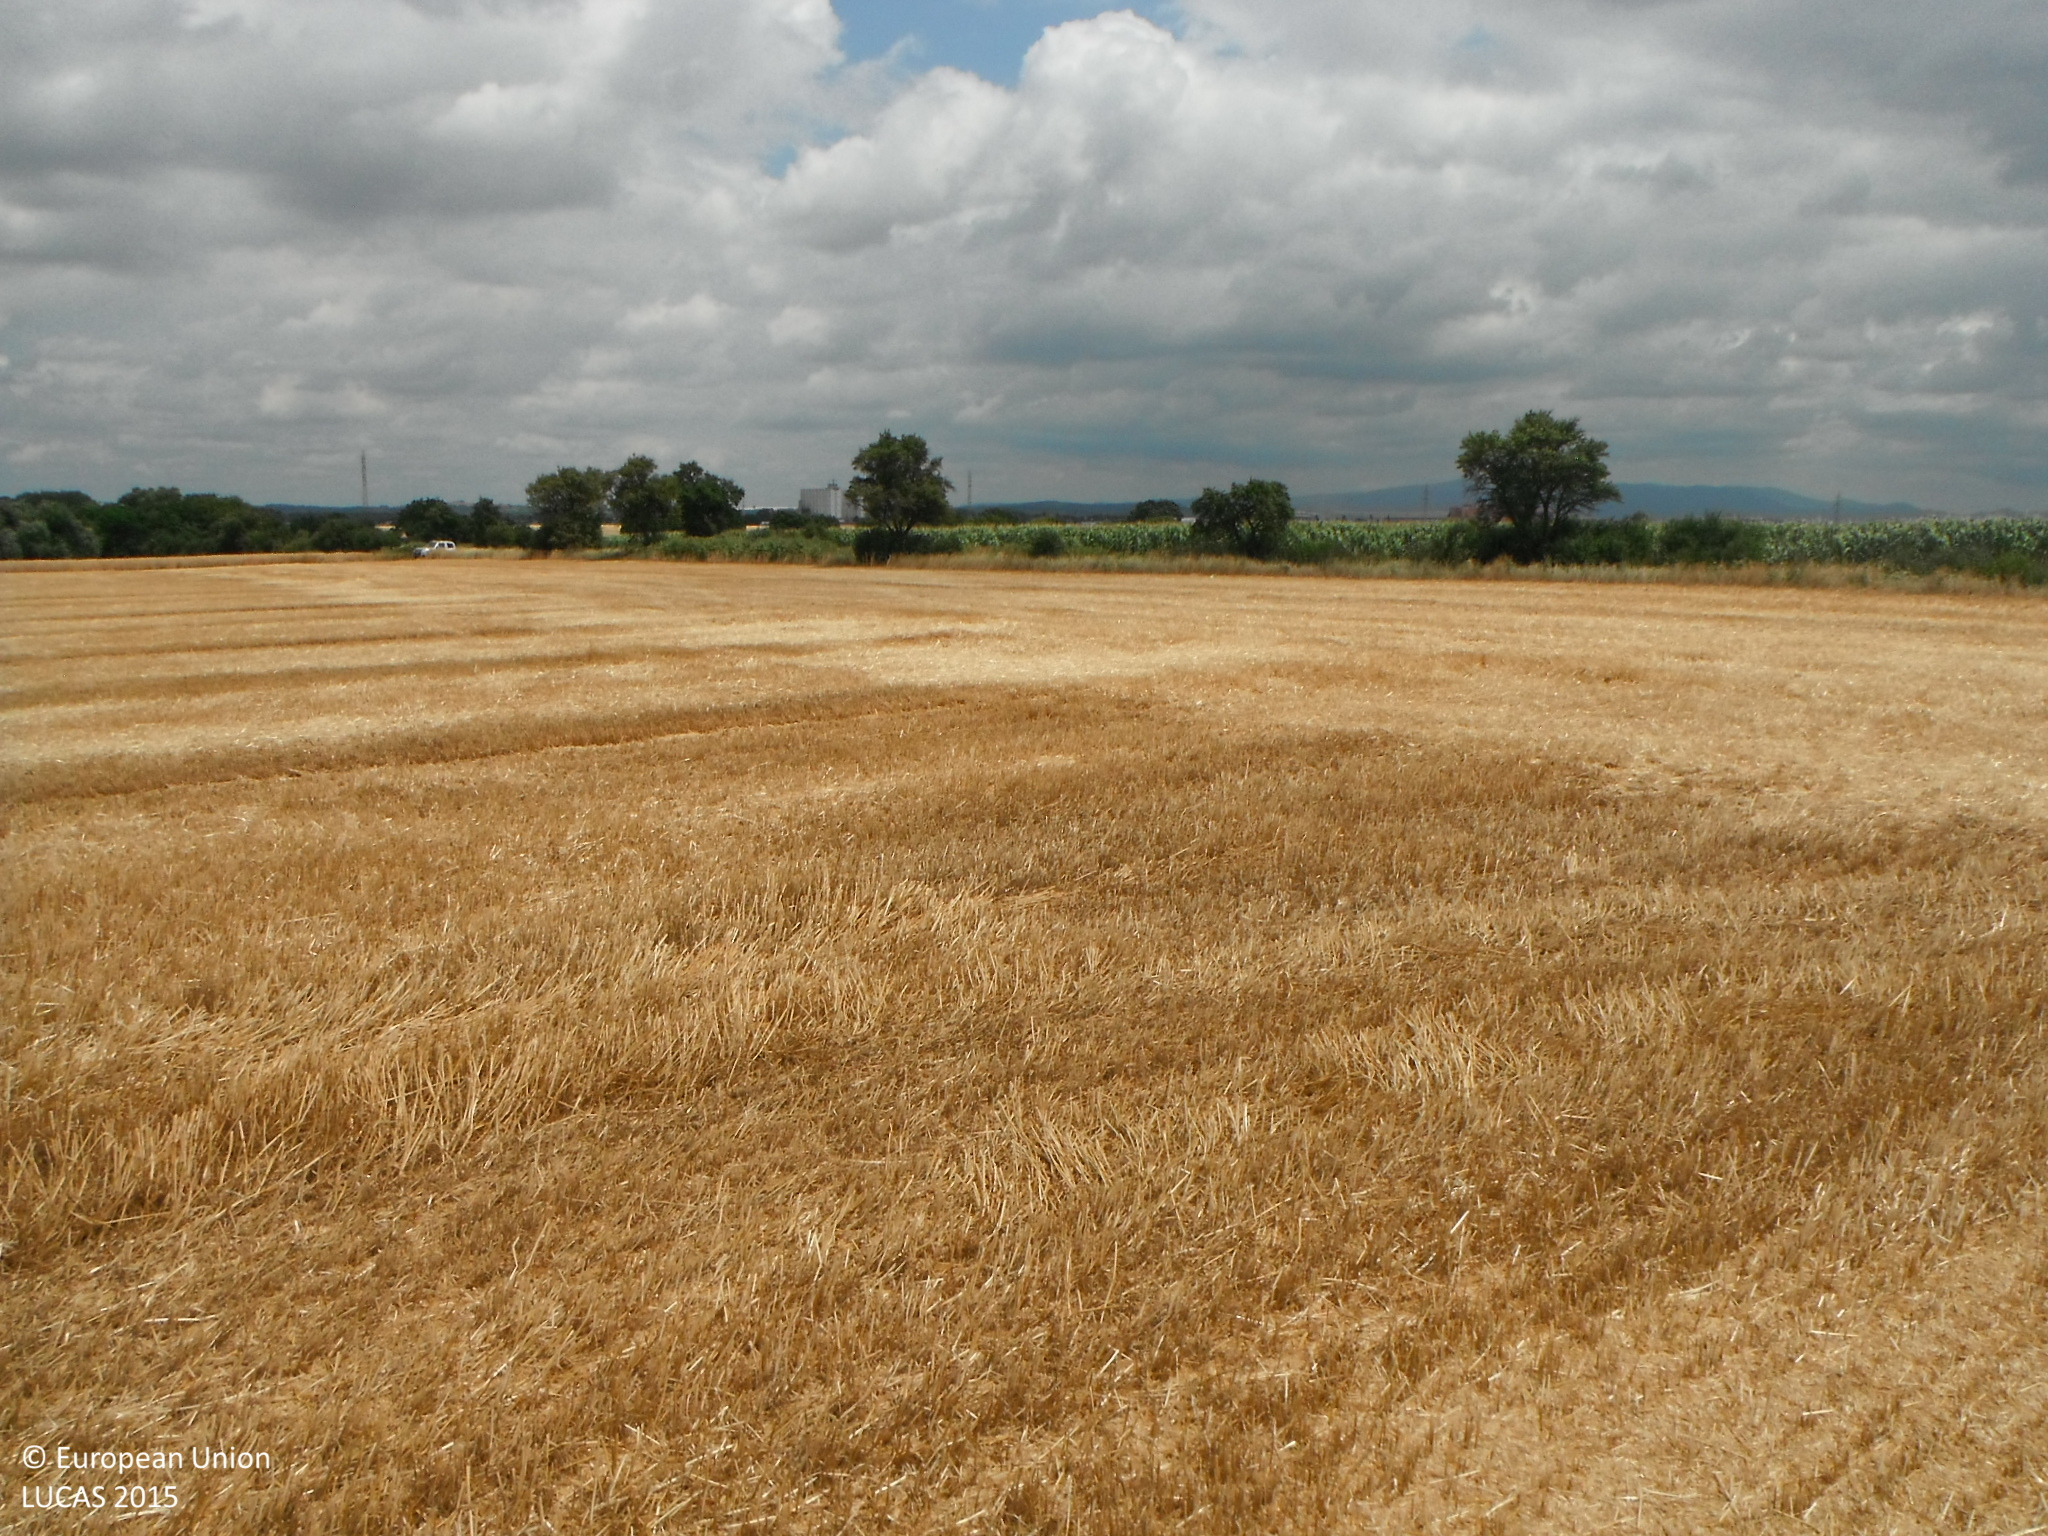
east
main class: Cropland
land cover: Common wheat
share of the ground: > 75 %
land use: Agriculture (excluding fallow land and kitchen gardens)
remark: Harvested field
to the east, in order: Common wheat; Shruby margins; Grass margins; Paved roads, cycling and walking lanes; Grass margins; Abandoned hedges; Maize
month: July
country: SK
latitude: 48.0486
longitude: 18.6156
